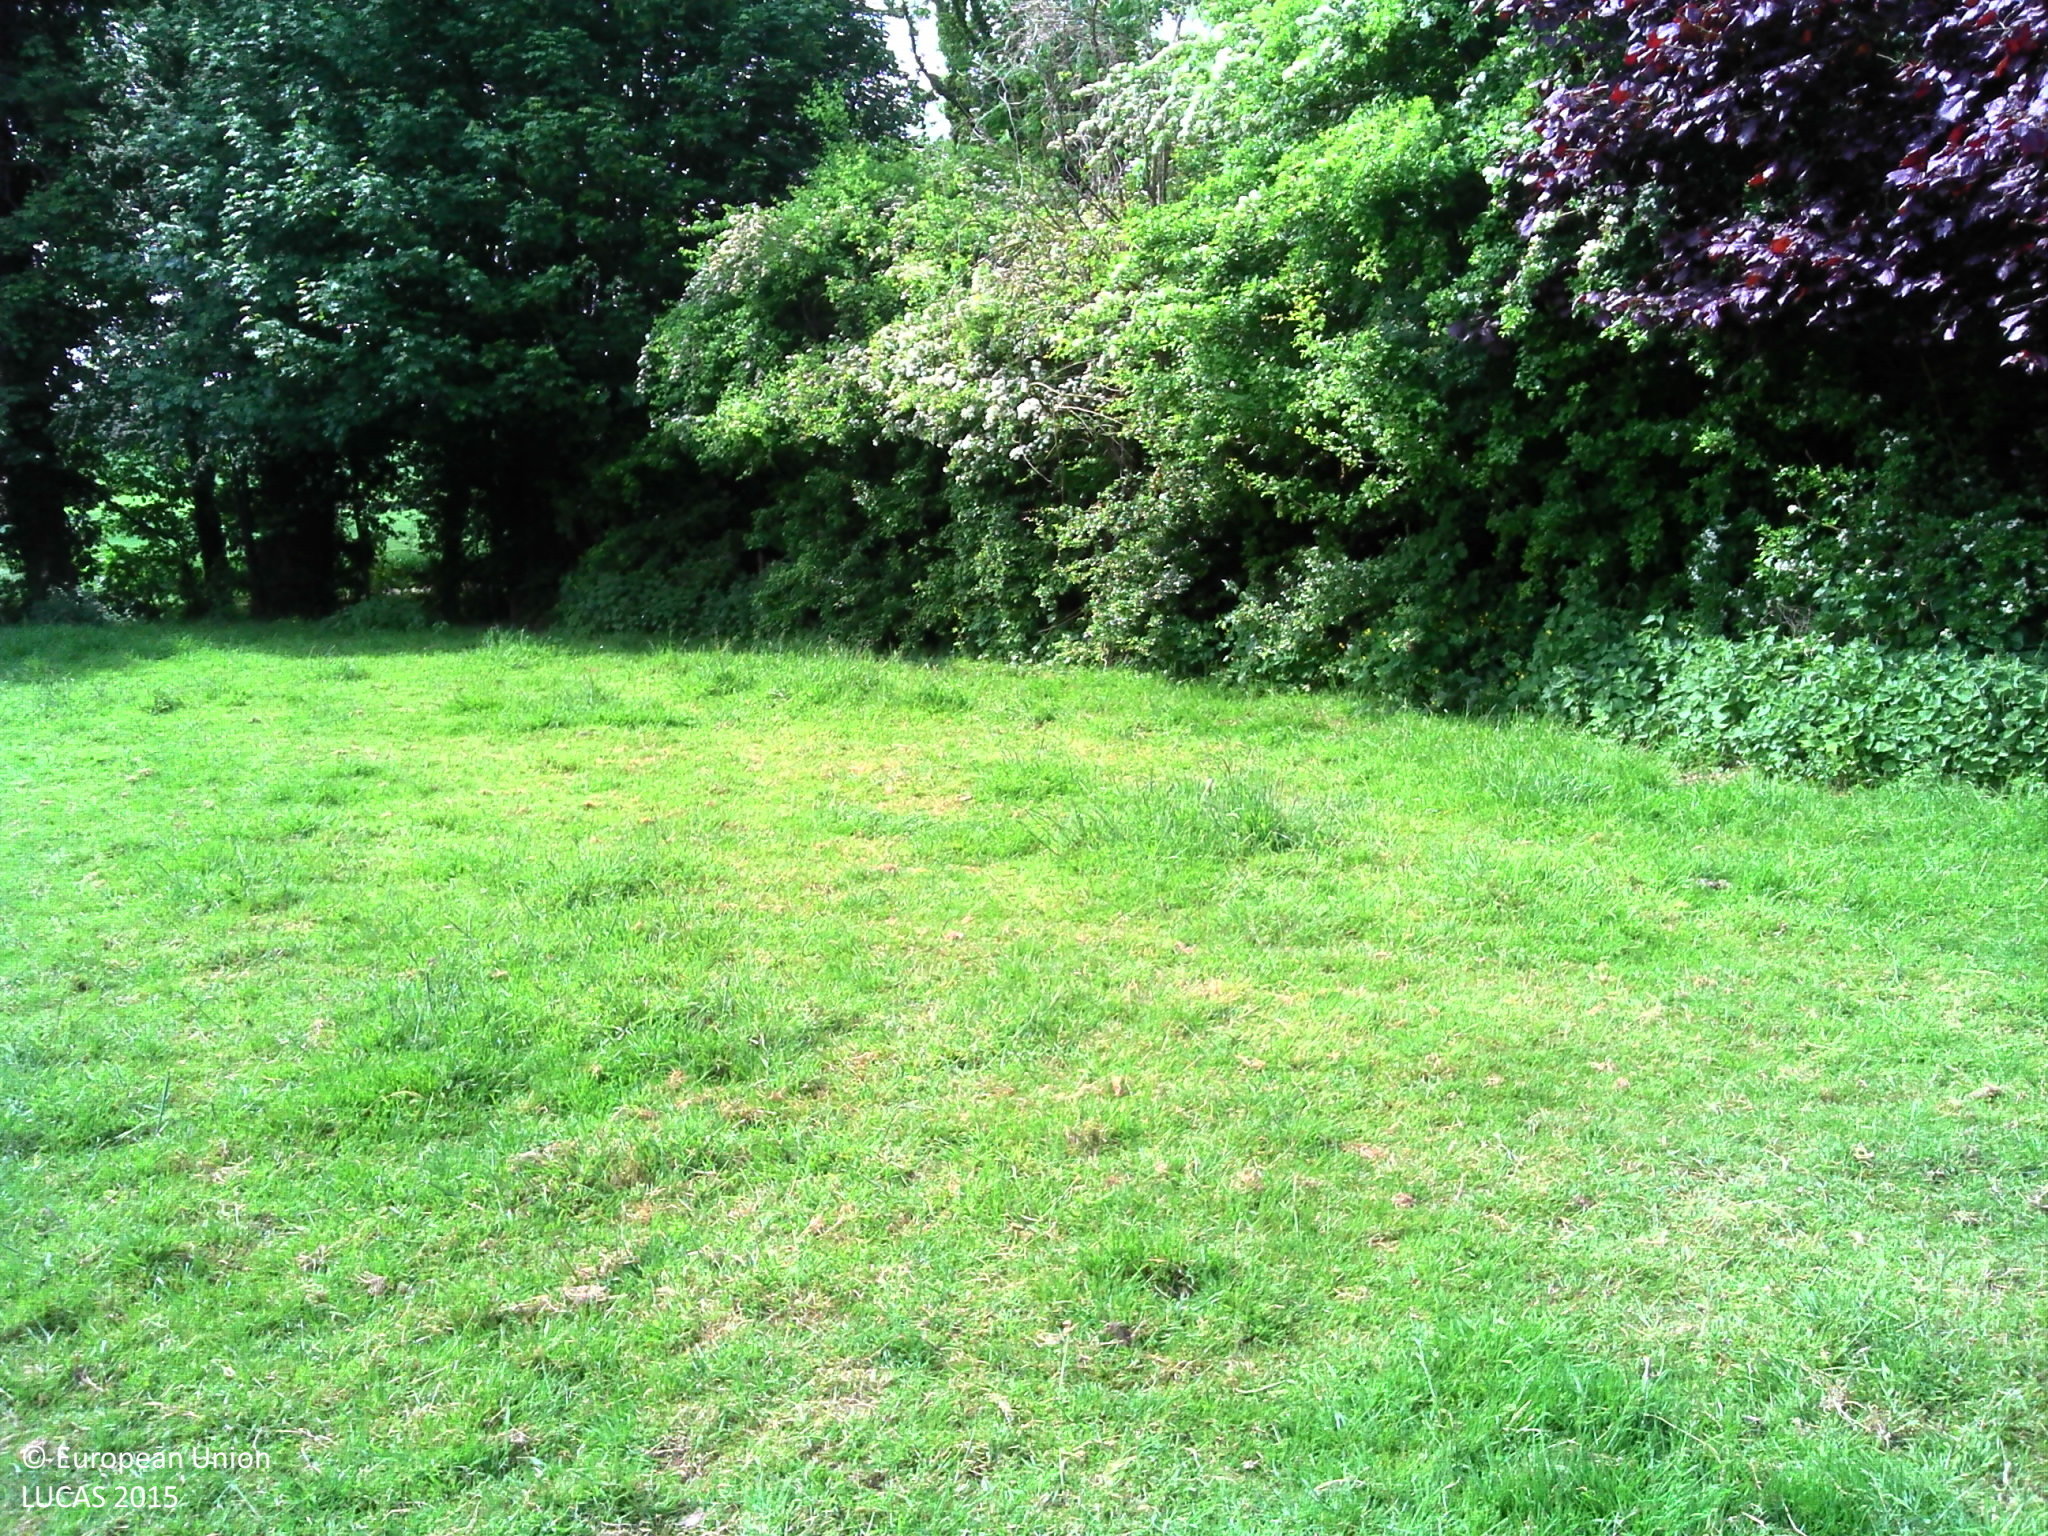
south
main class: Grassland
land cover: Grassland without tree/shrub cover
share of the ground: > 75 %
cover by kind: herbaceous plants 100 %
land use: Agriculture (excluding fallow land and kitchen gardens)
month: May
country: FR
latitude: 50.5949
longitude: 2.3438
